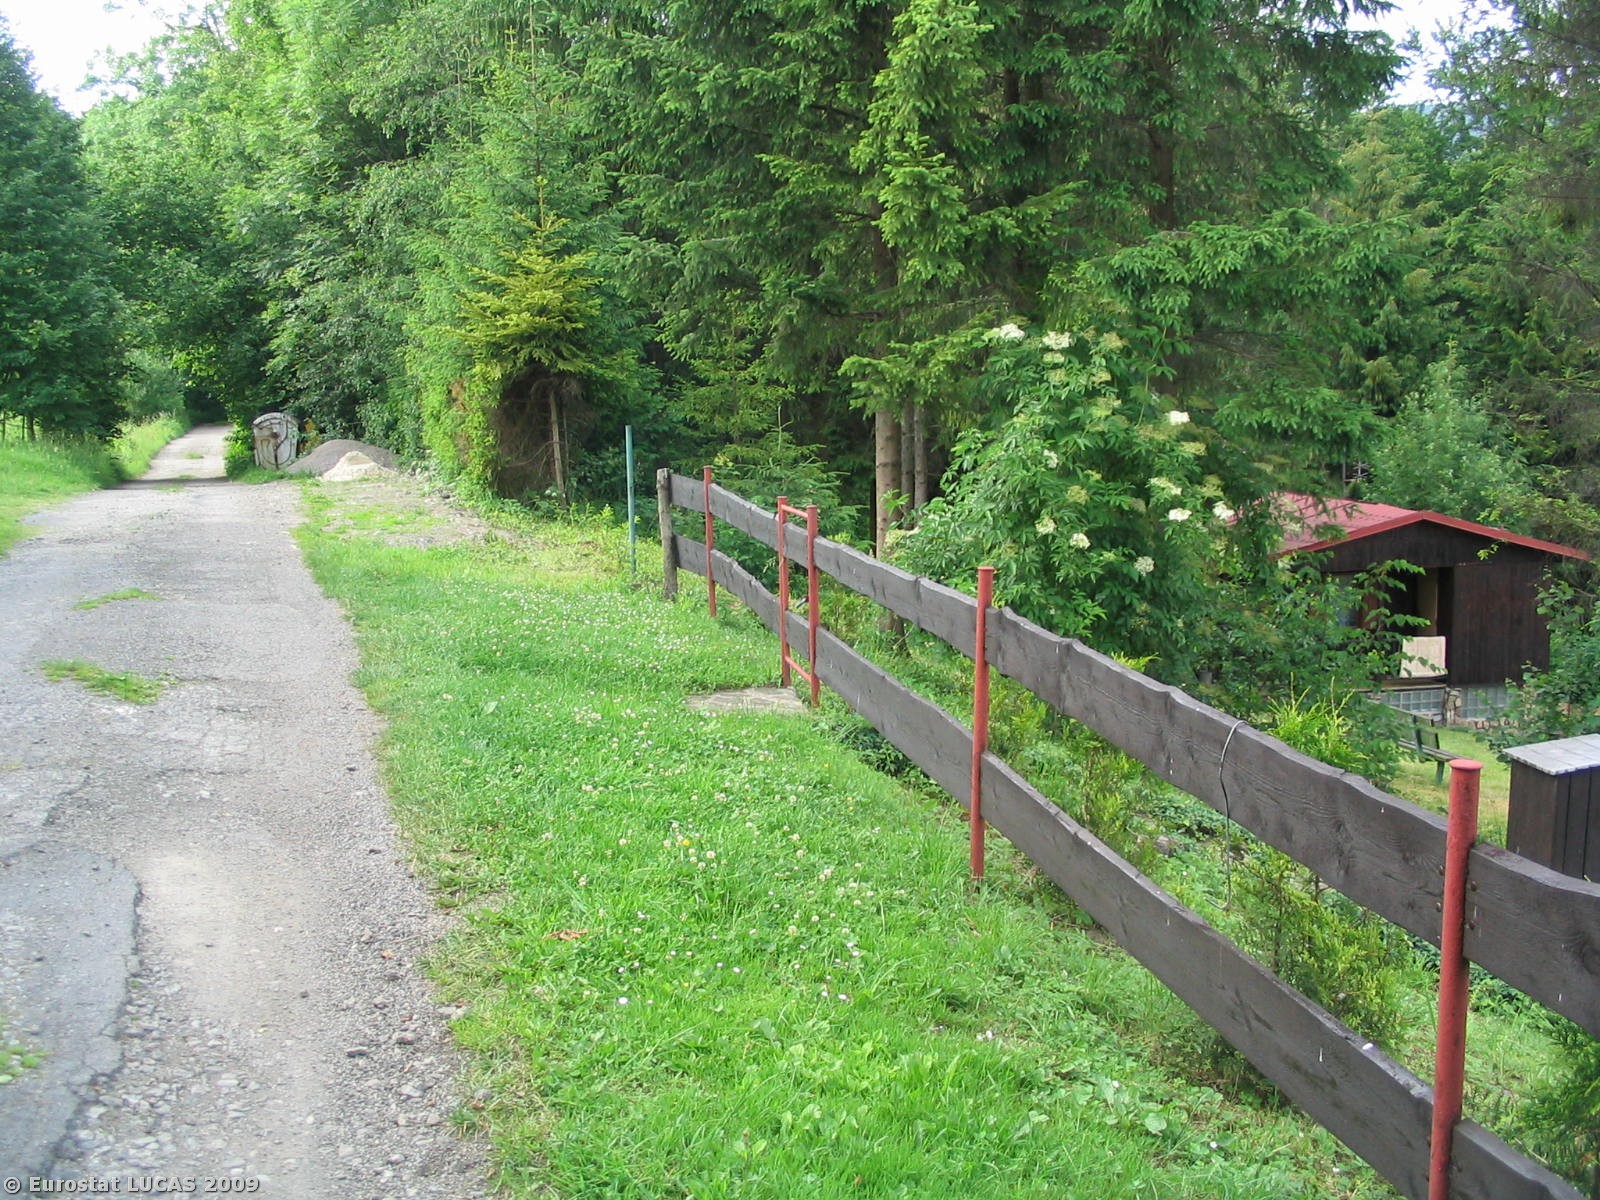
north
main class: Grassland
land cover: Grassland without tree/shrub cover
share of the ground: > 75 %
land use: Residential
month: June
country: CZ
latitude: 49.6654
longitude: 18.7630
